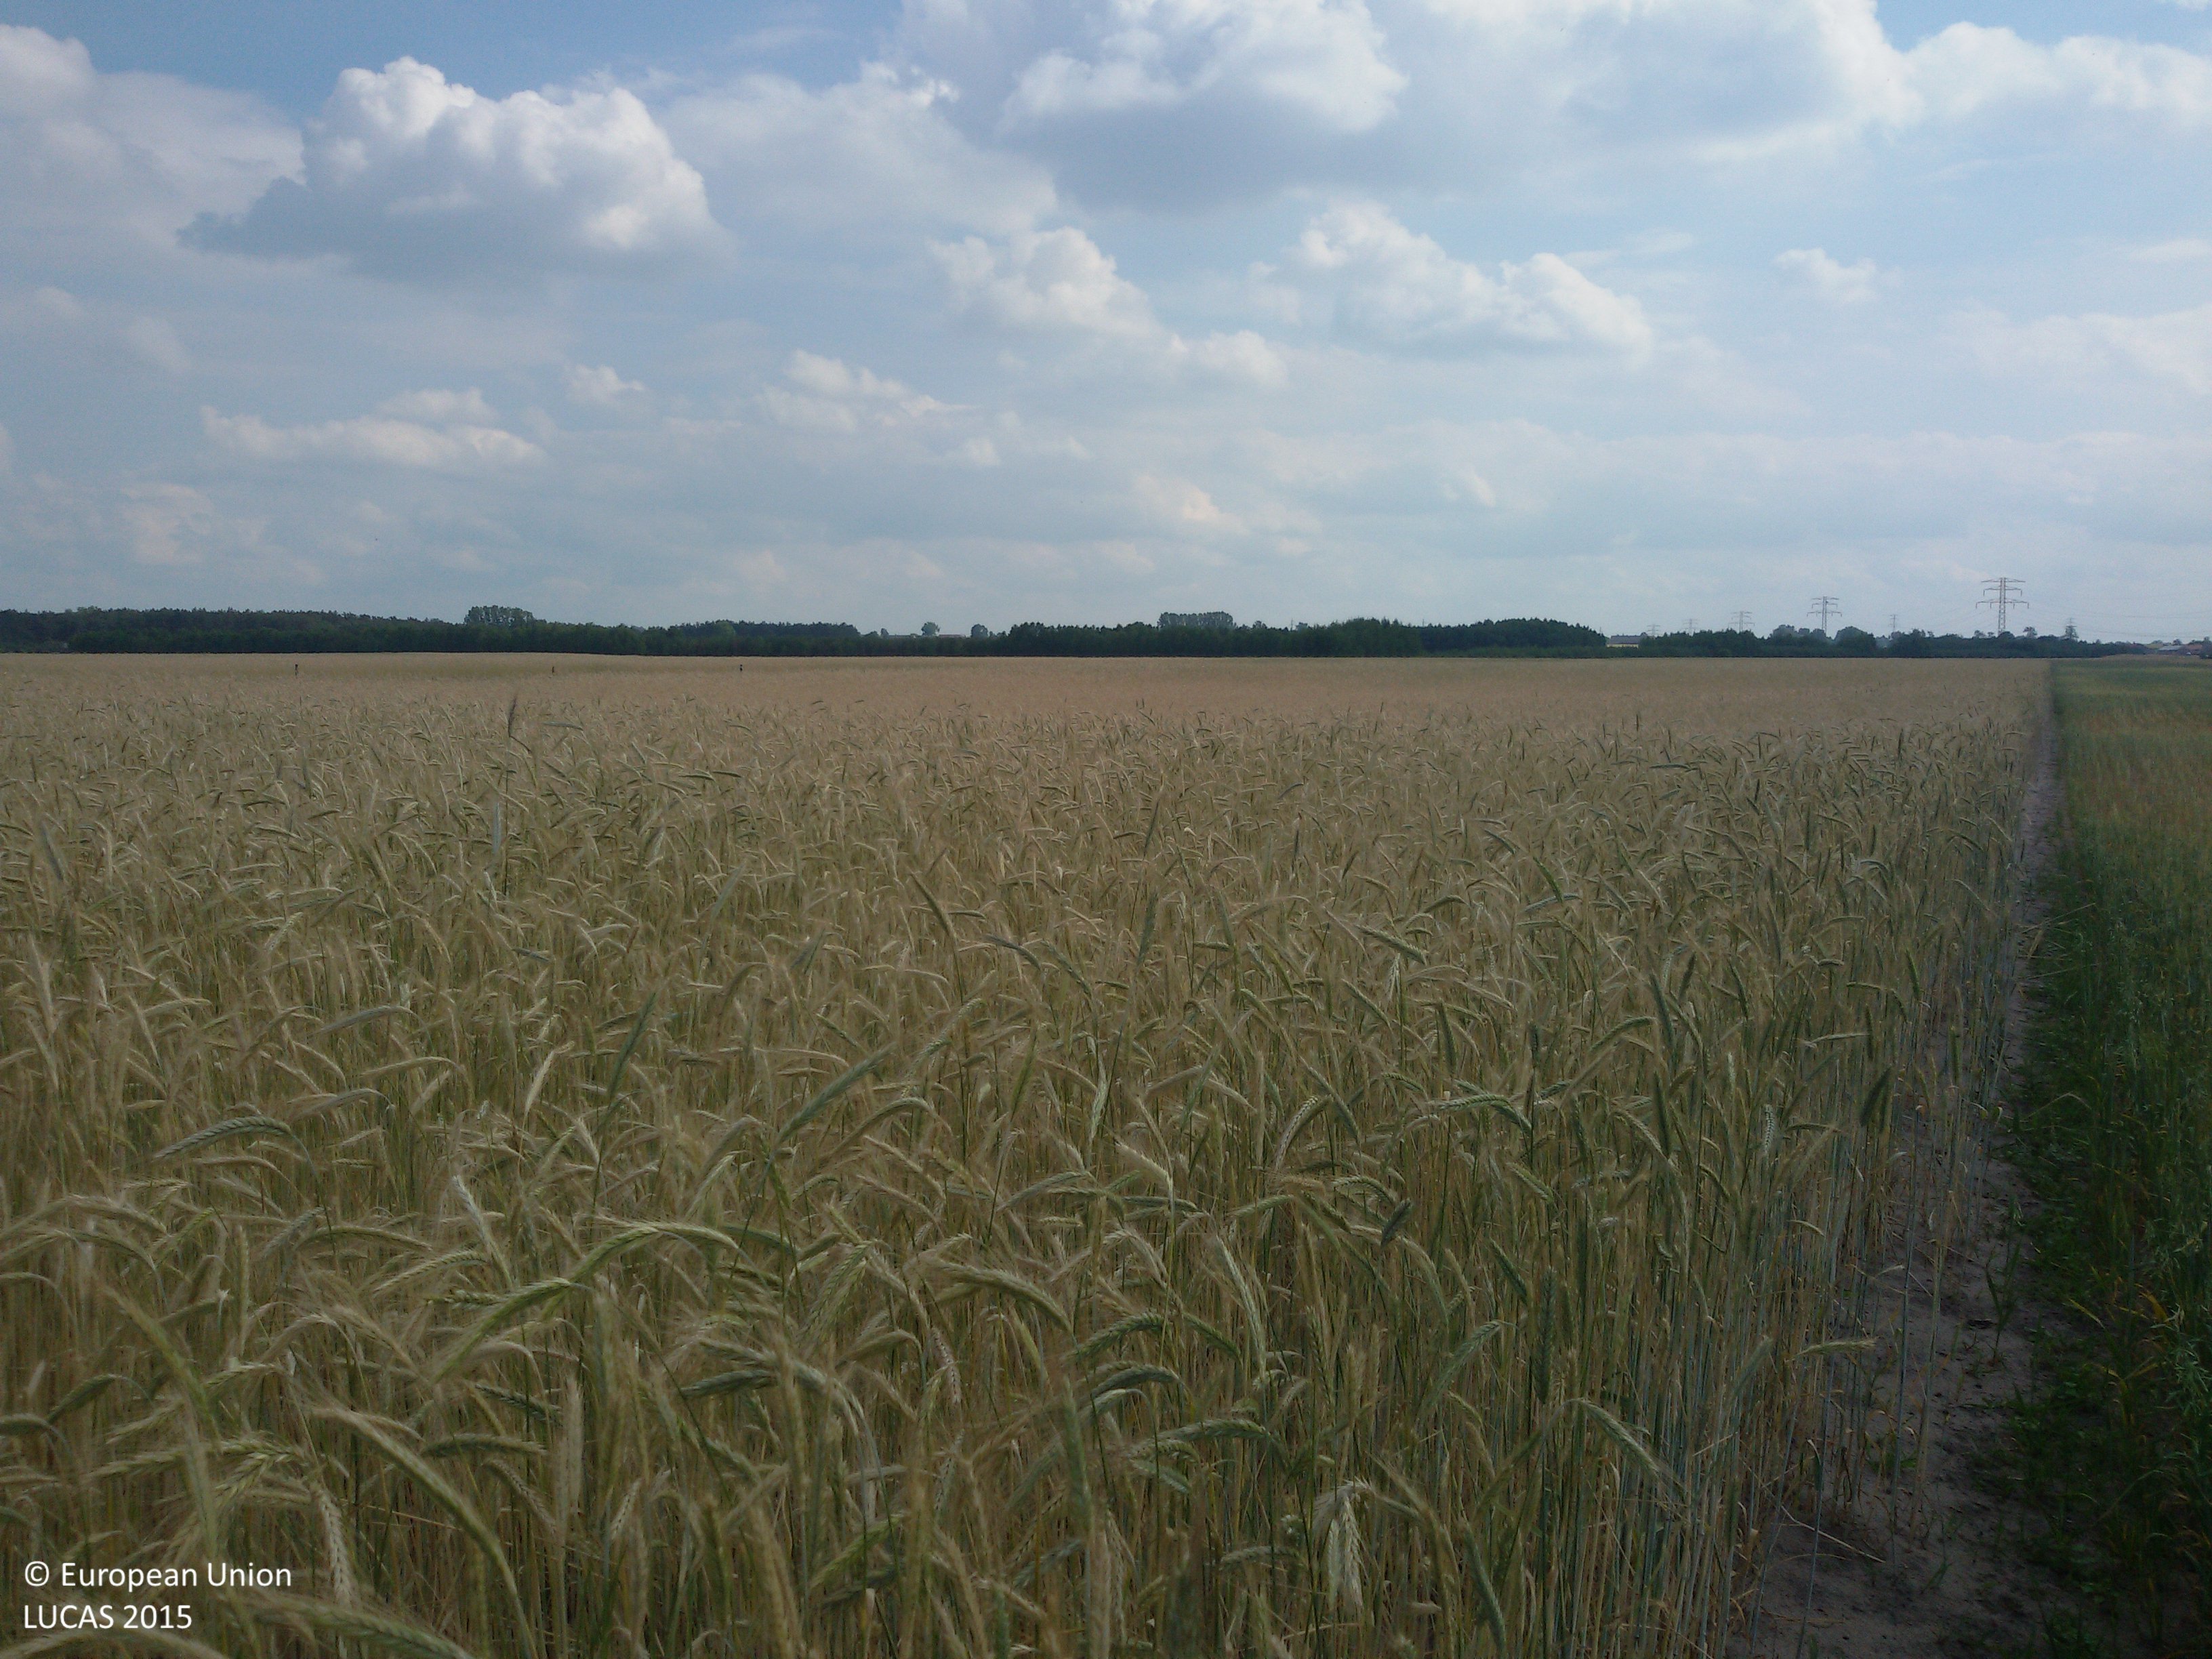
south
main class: Cropland
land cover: Barley
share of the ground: 50 - 75 %
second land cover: Oats
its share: 25 - 50 %
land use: Agriculture (excluding fallow land and kitchen gardens)
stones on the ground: < 10 %
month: June
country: PL
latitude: 52.5726
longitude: 19.0685
